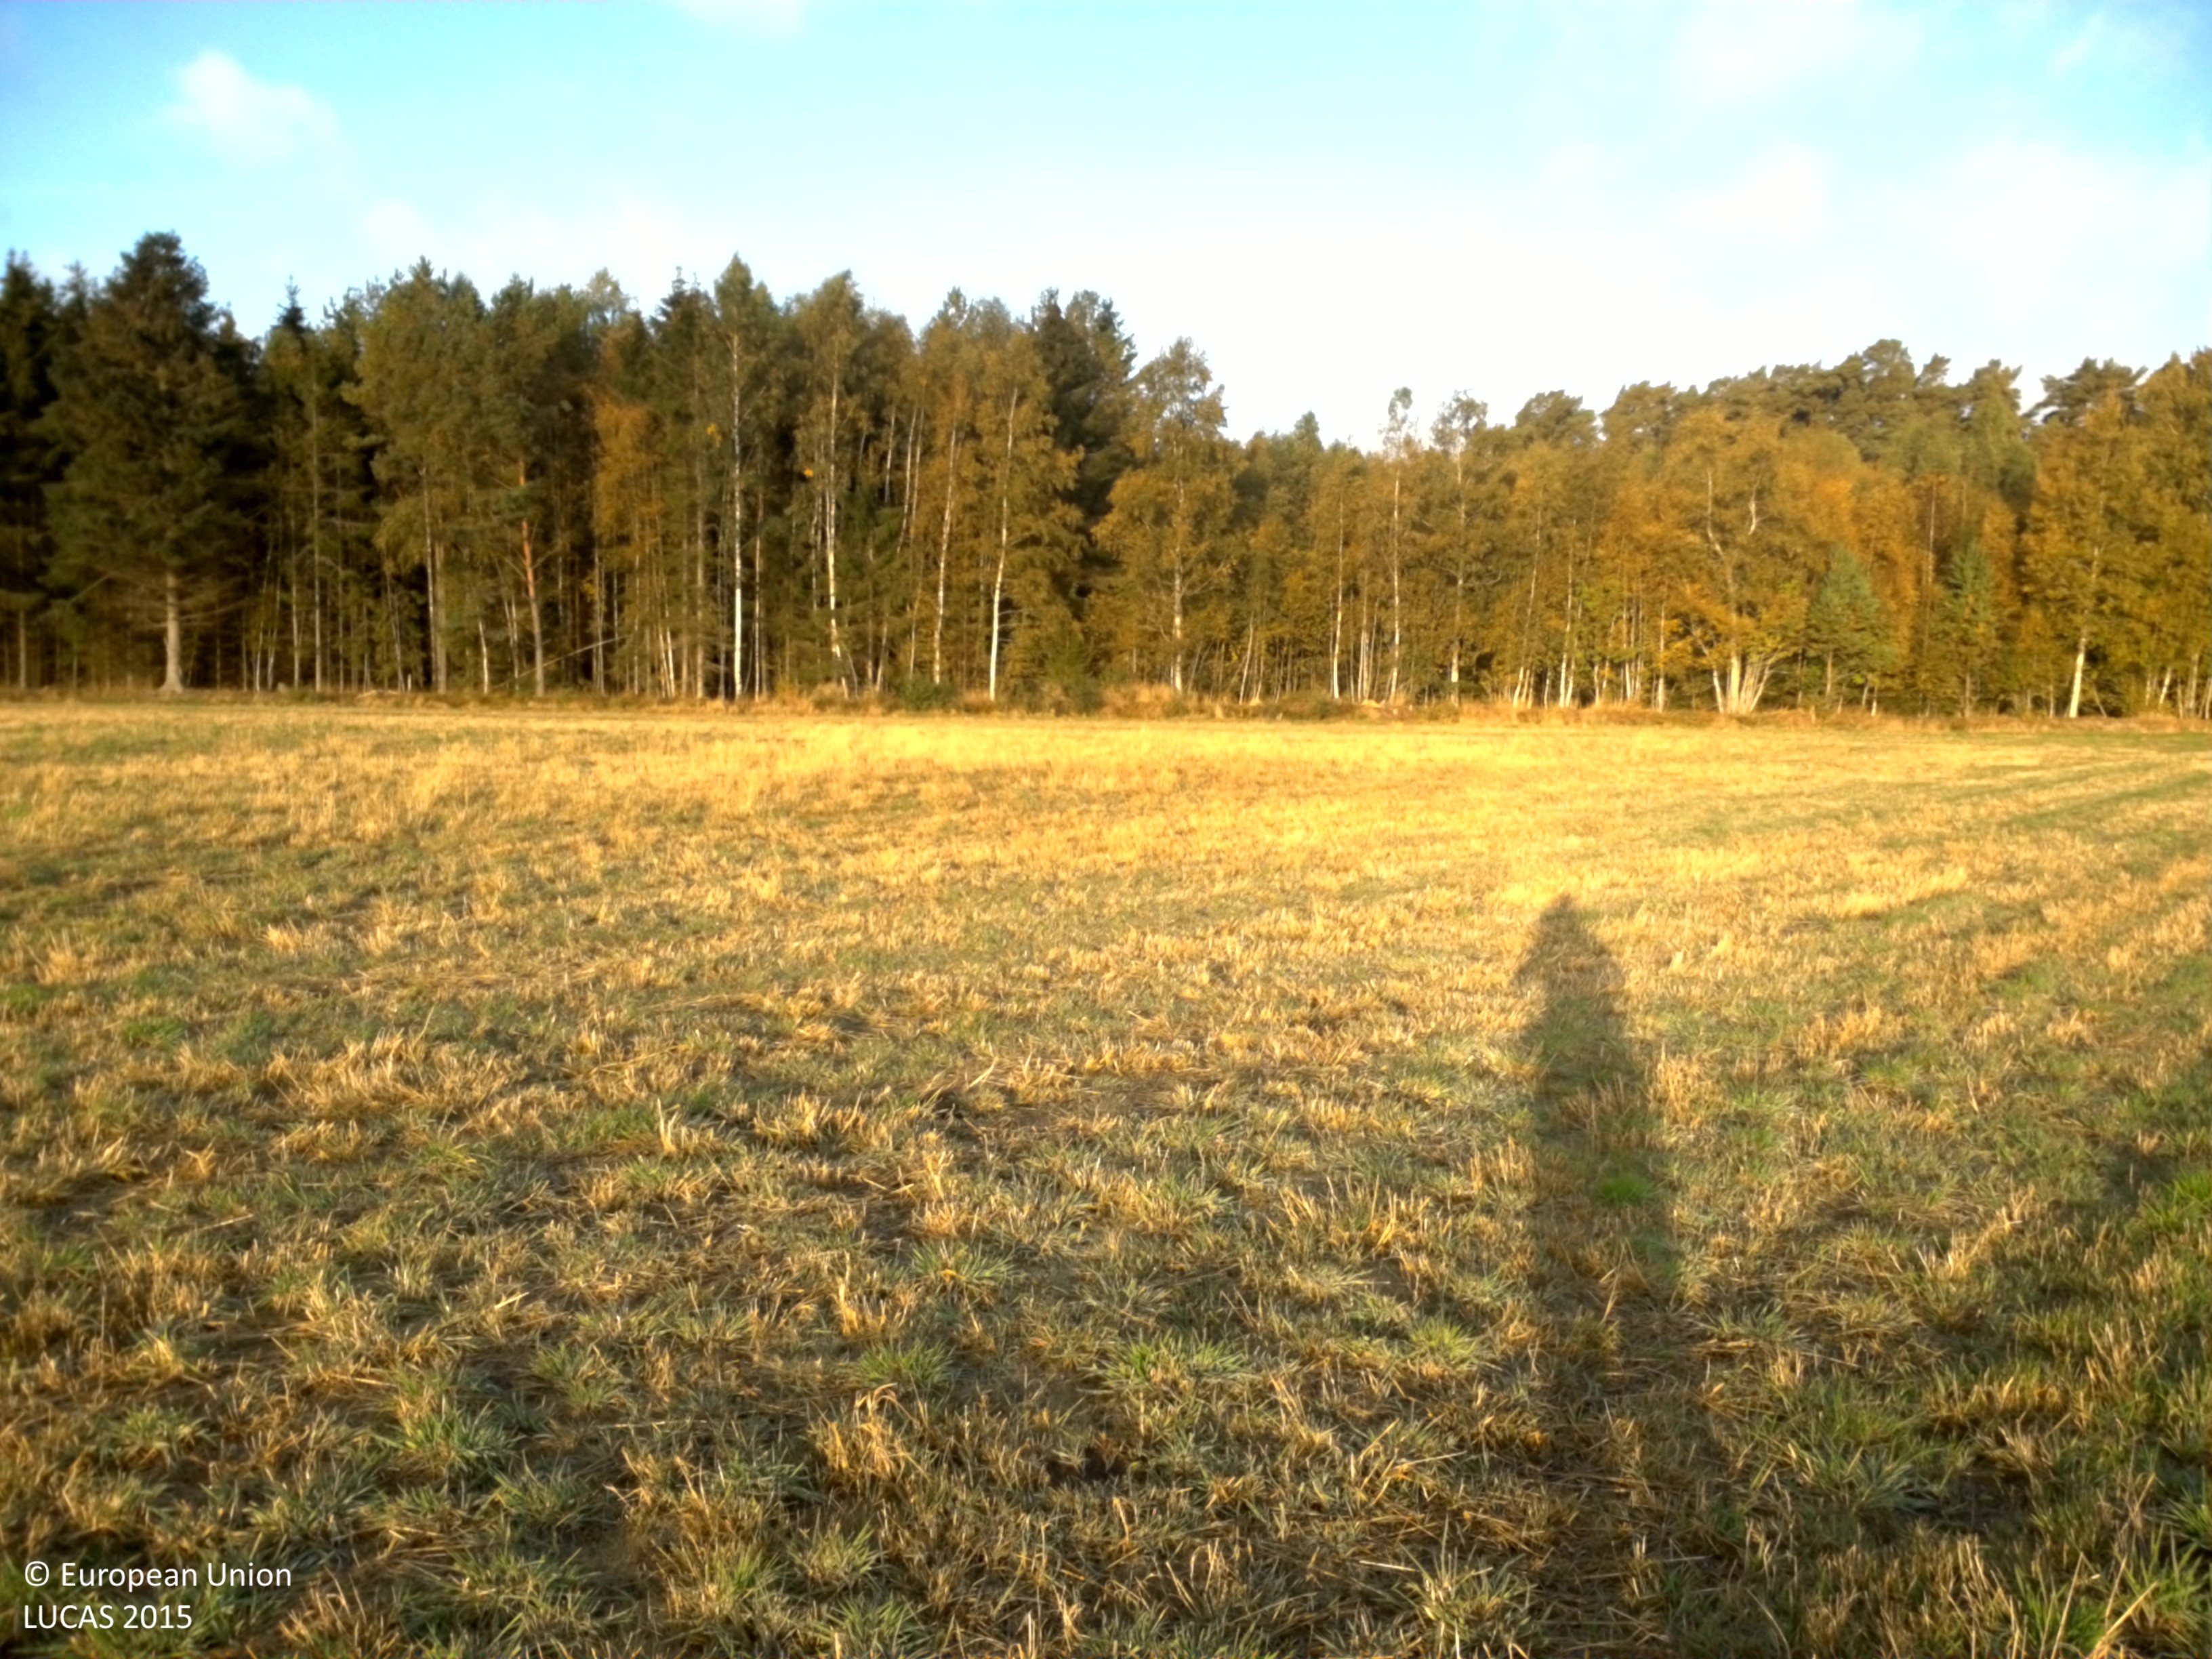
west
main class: Grassland
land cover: Grassland without tree/shrub cover
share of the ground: > 75 %
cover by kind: herbaceous plants 100 %
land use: Agriculture (excluding fallow land and kitchen gardens)
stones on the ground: < 10 %
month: October
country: SE
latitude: 58.2406
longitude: 12.9757
